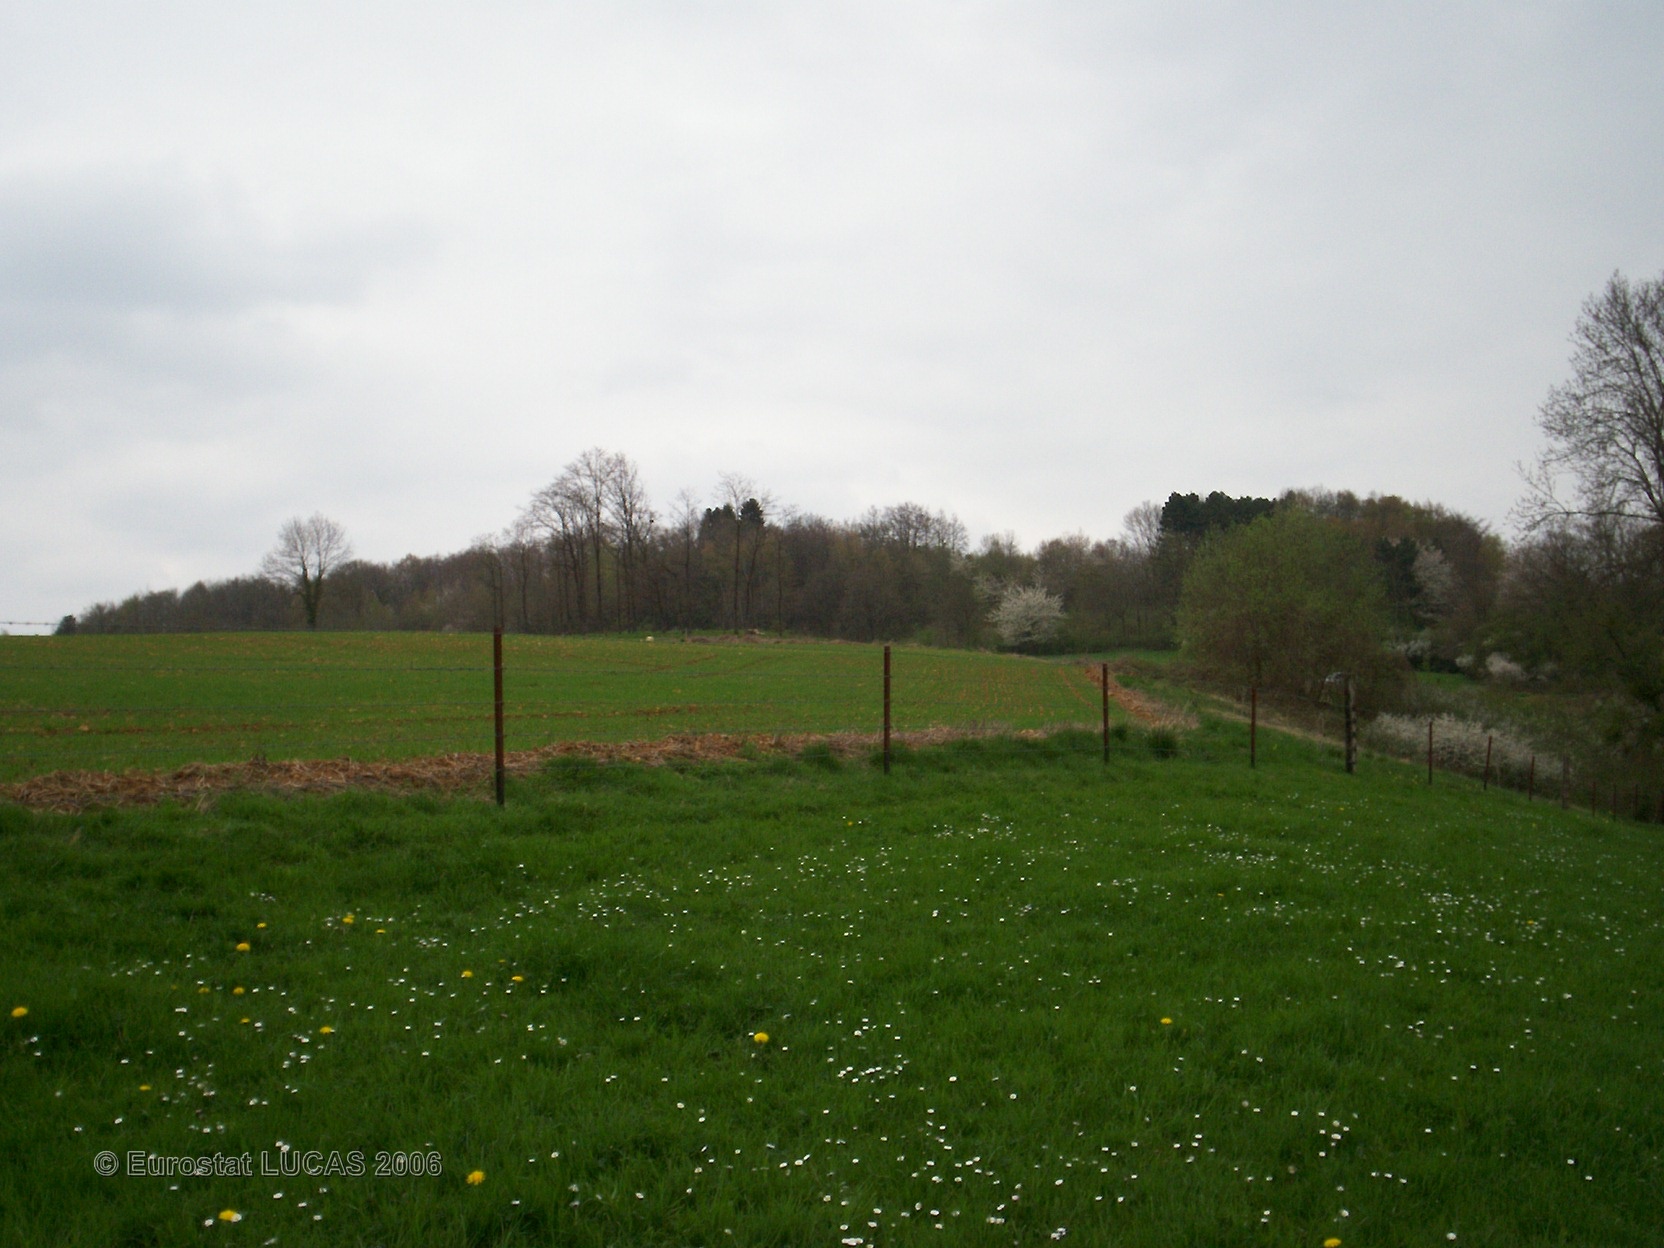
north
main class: Grassland
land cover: Grassland without tree/shrub cover
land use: Agriculture (excluding fallow land and kitchen gardens)
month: April
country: FR
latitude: 49.7651
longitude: 4.5401
